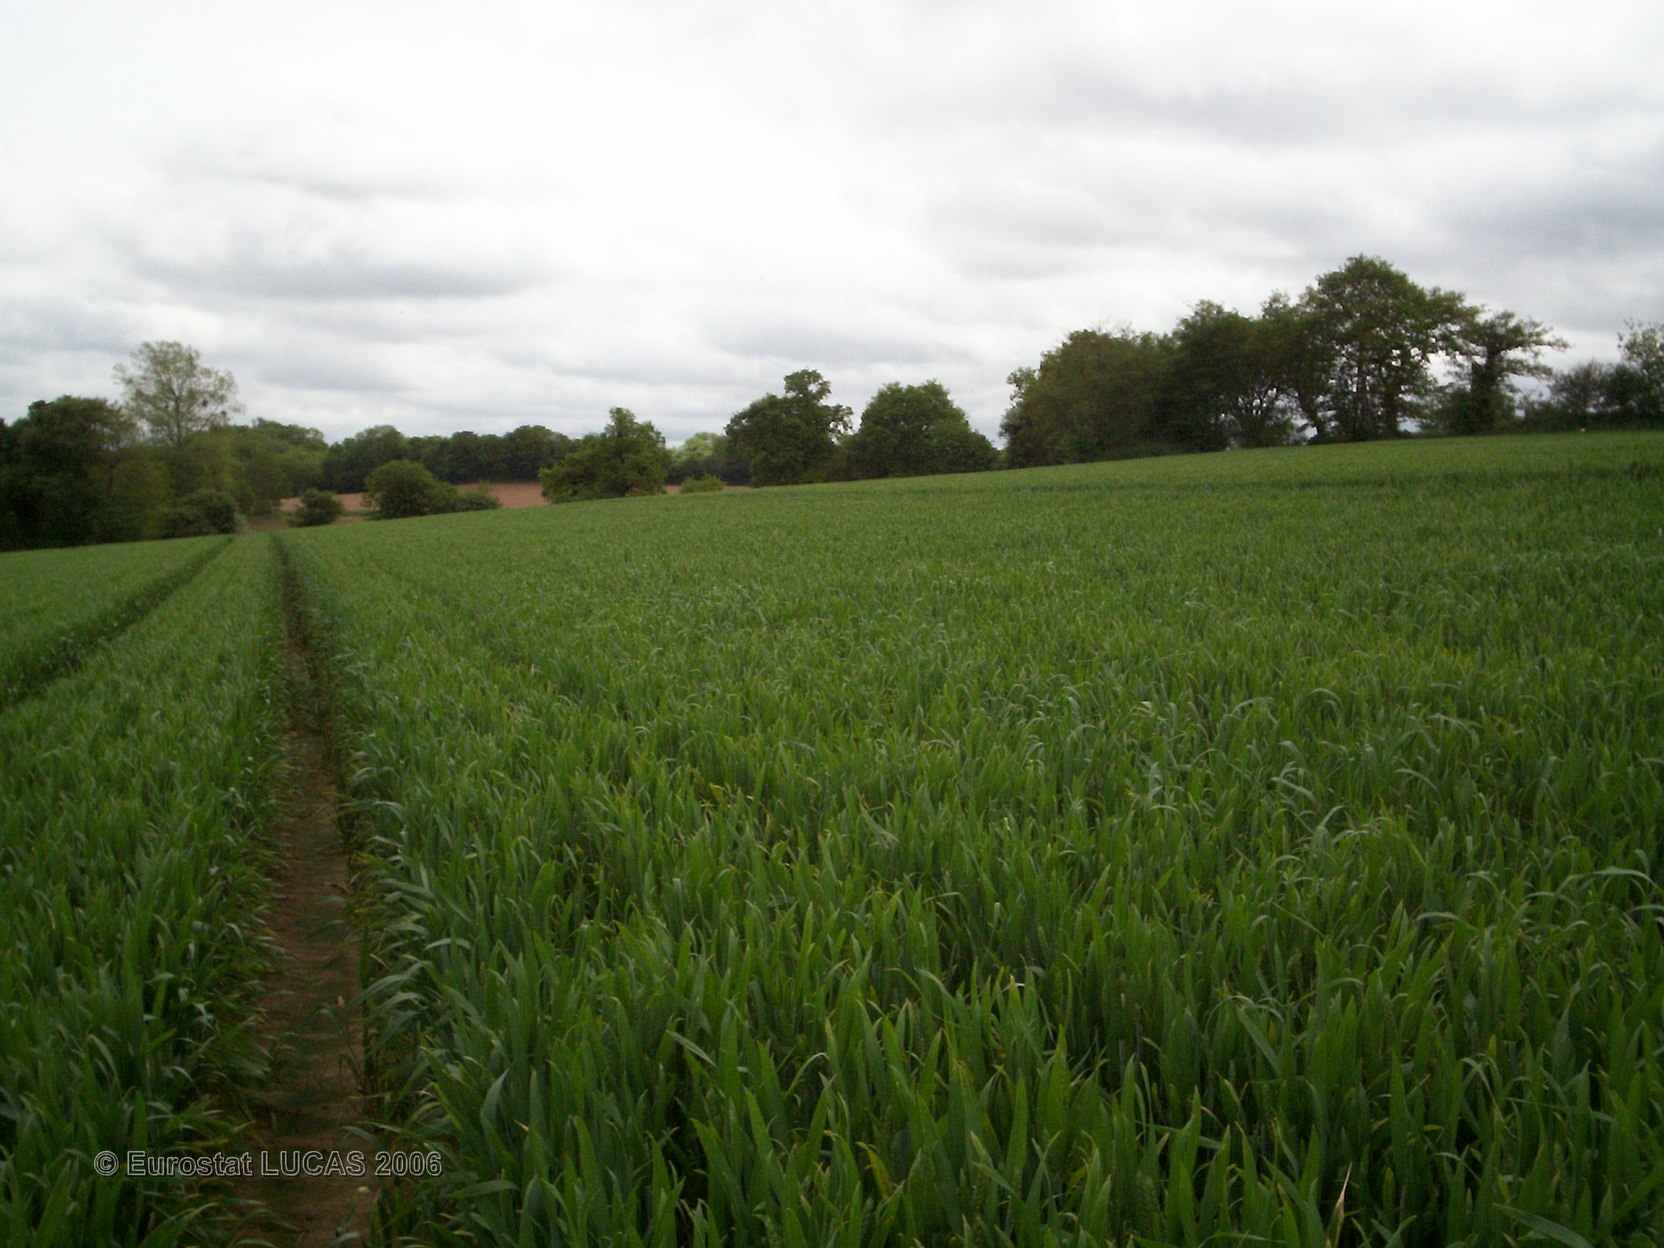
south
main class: Cropland
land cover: Common wheat
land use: Agriculture (excluding fallow land and kitchen gardens)
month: May
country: FR
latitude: 48.6309
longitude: -3.0291
